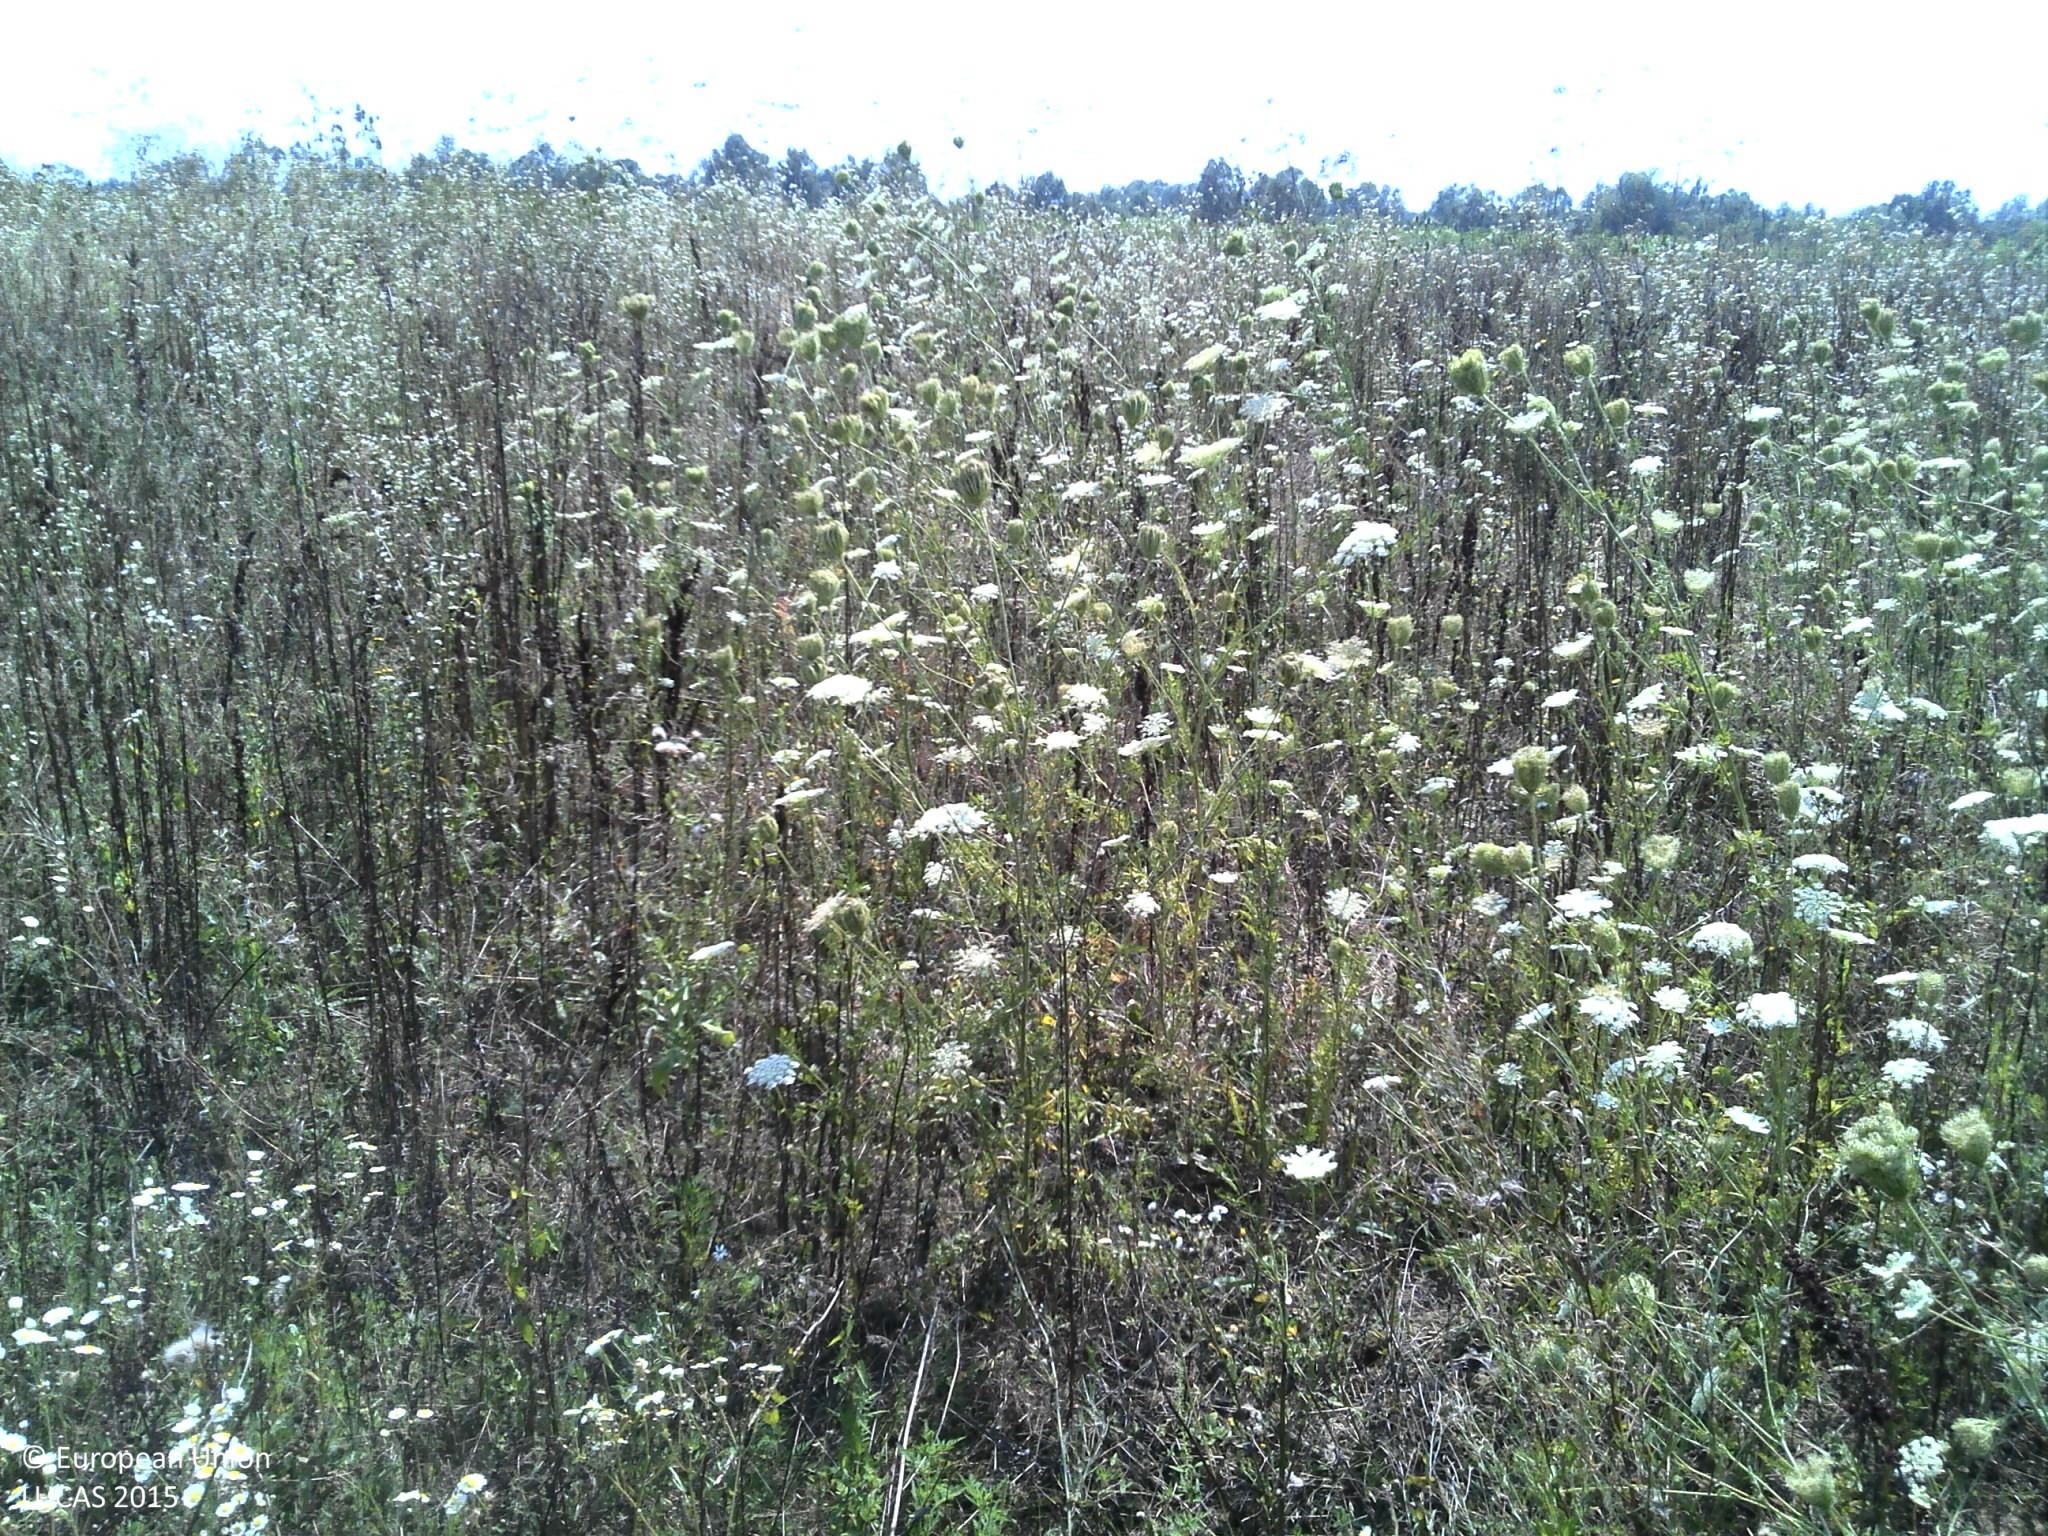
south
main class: Grassland
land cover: Spontaneously vegetated surfaces
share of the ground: > 75 %
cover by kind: herbaceous plants 100 %
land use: Fallow land
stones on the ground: < 10 %
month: August
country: HR
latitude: 45.2619
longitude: 17.1487
